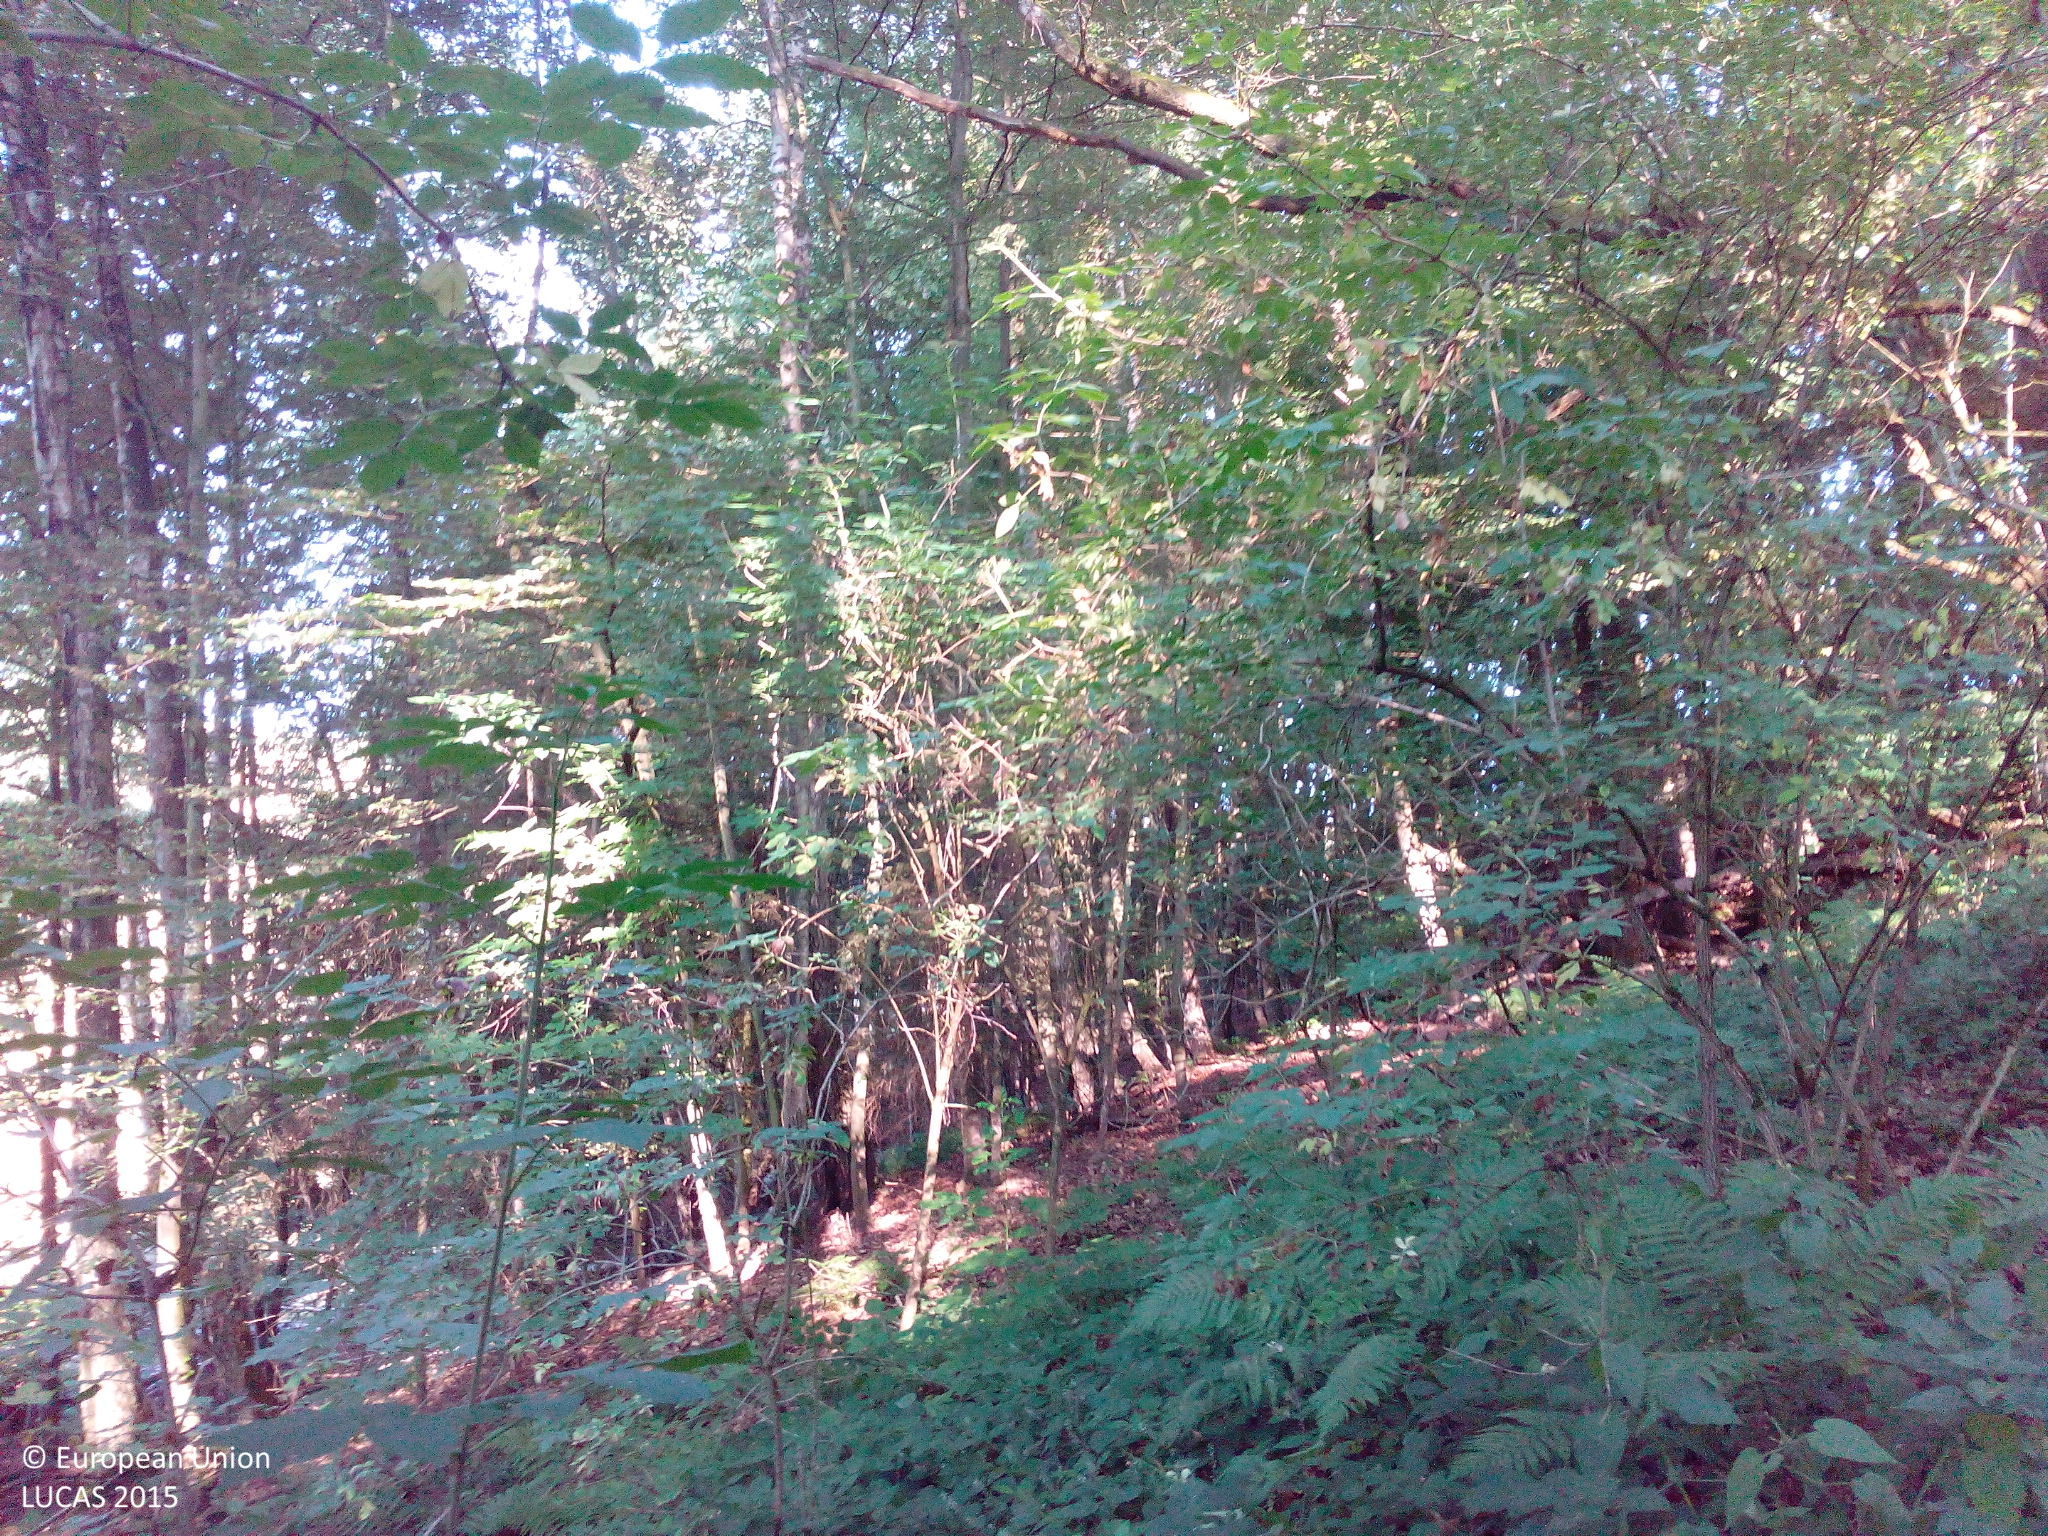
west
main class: Woodland
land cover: Broadleaved woodland
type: mesophytic deciduous forest
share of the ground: 50 - 75 %
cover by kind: broadleaved forest trees 70 %, shrubs 10 %, herbaceous plants 10 %, unconsolidated bare surface 10 %
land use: Forestry
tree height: > 5 m
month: July
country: DE
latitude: 49.2946
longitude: 7.5667
